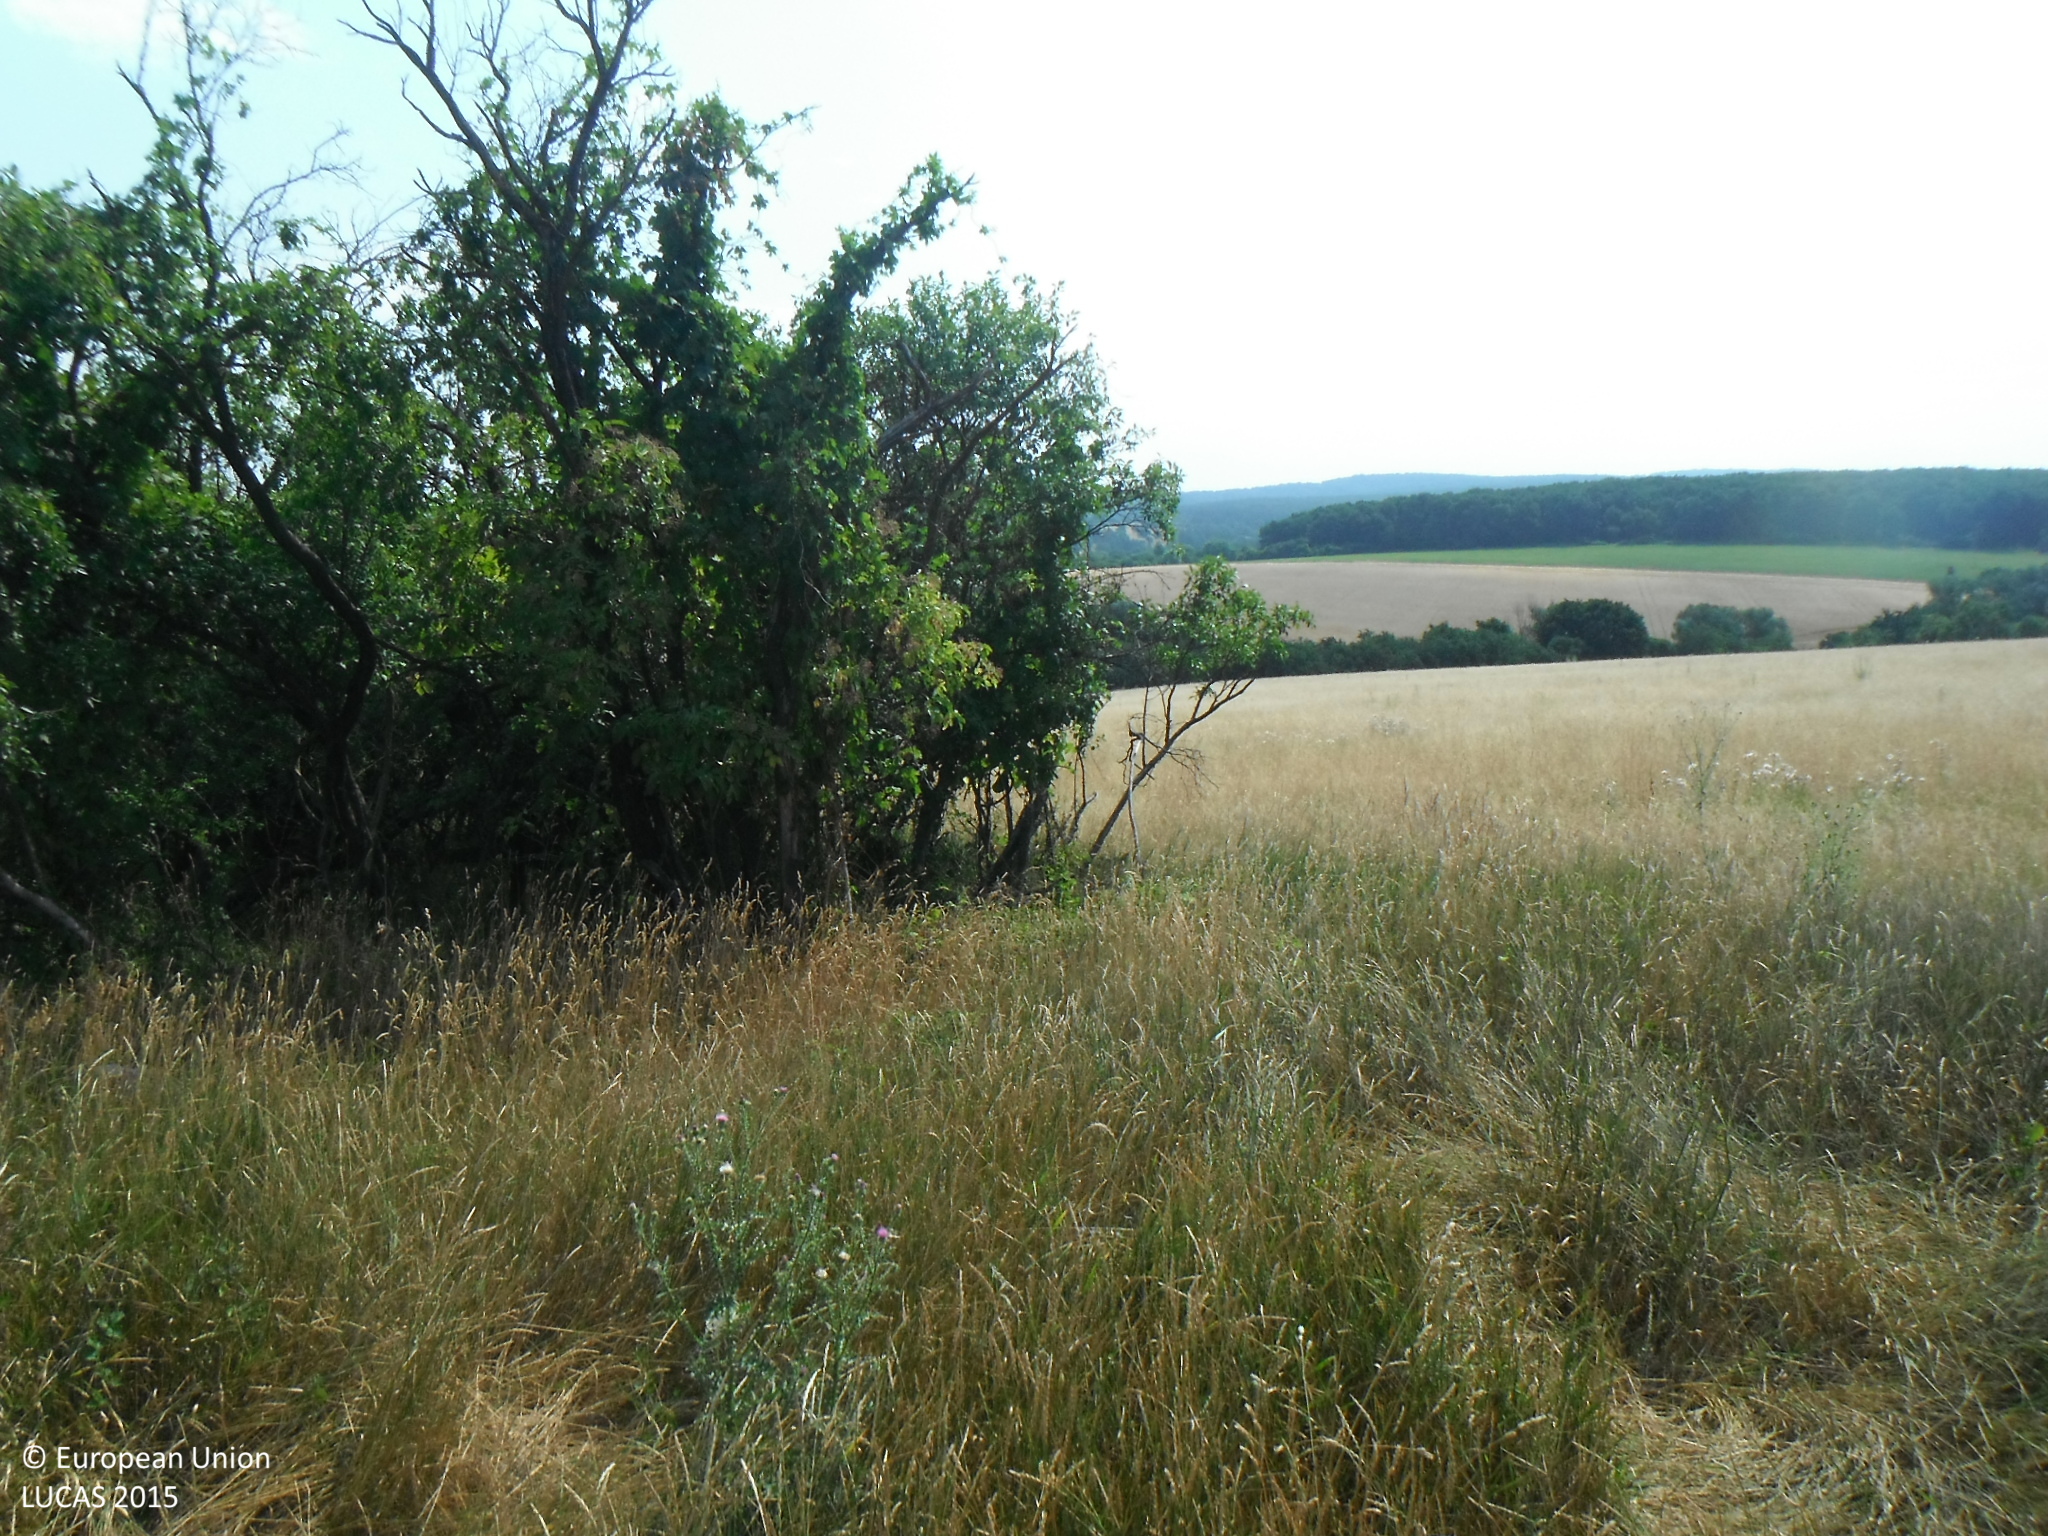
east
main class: Grassland
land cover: Spontaneously vegetated surfaces
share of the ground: > 75 %
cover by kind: herbaceous plants 95 %, shrubs 5 %
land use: Semi-natural and natural areas not in use
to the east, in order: Spontaneously vegetated surfaces; Broadleaved woodland; Grassland without tree/shrub cover; Broadleaved woodland; Rivers and streams; Broadleaved woodland; Barley
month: July
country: SK
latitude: 48.8323
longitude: 17.2711
